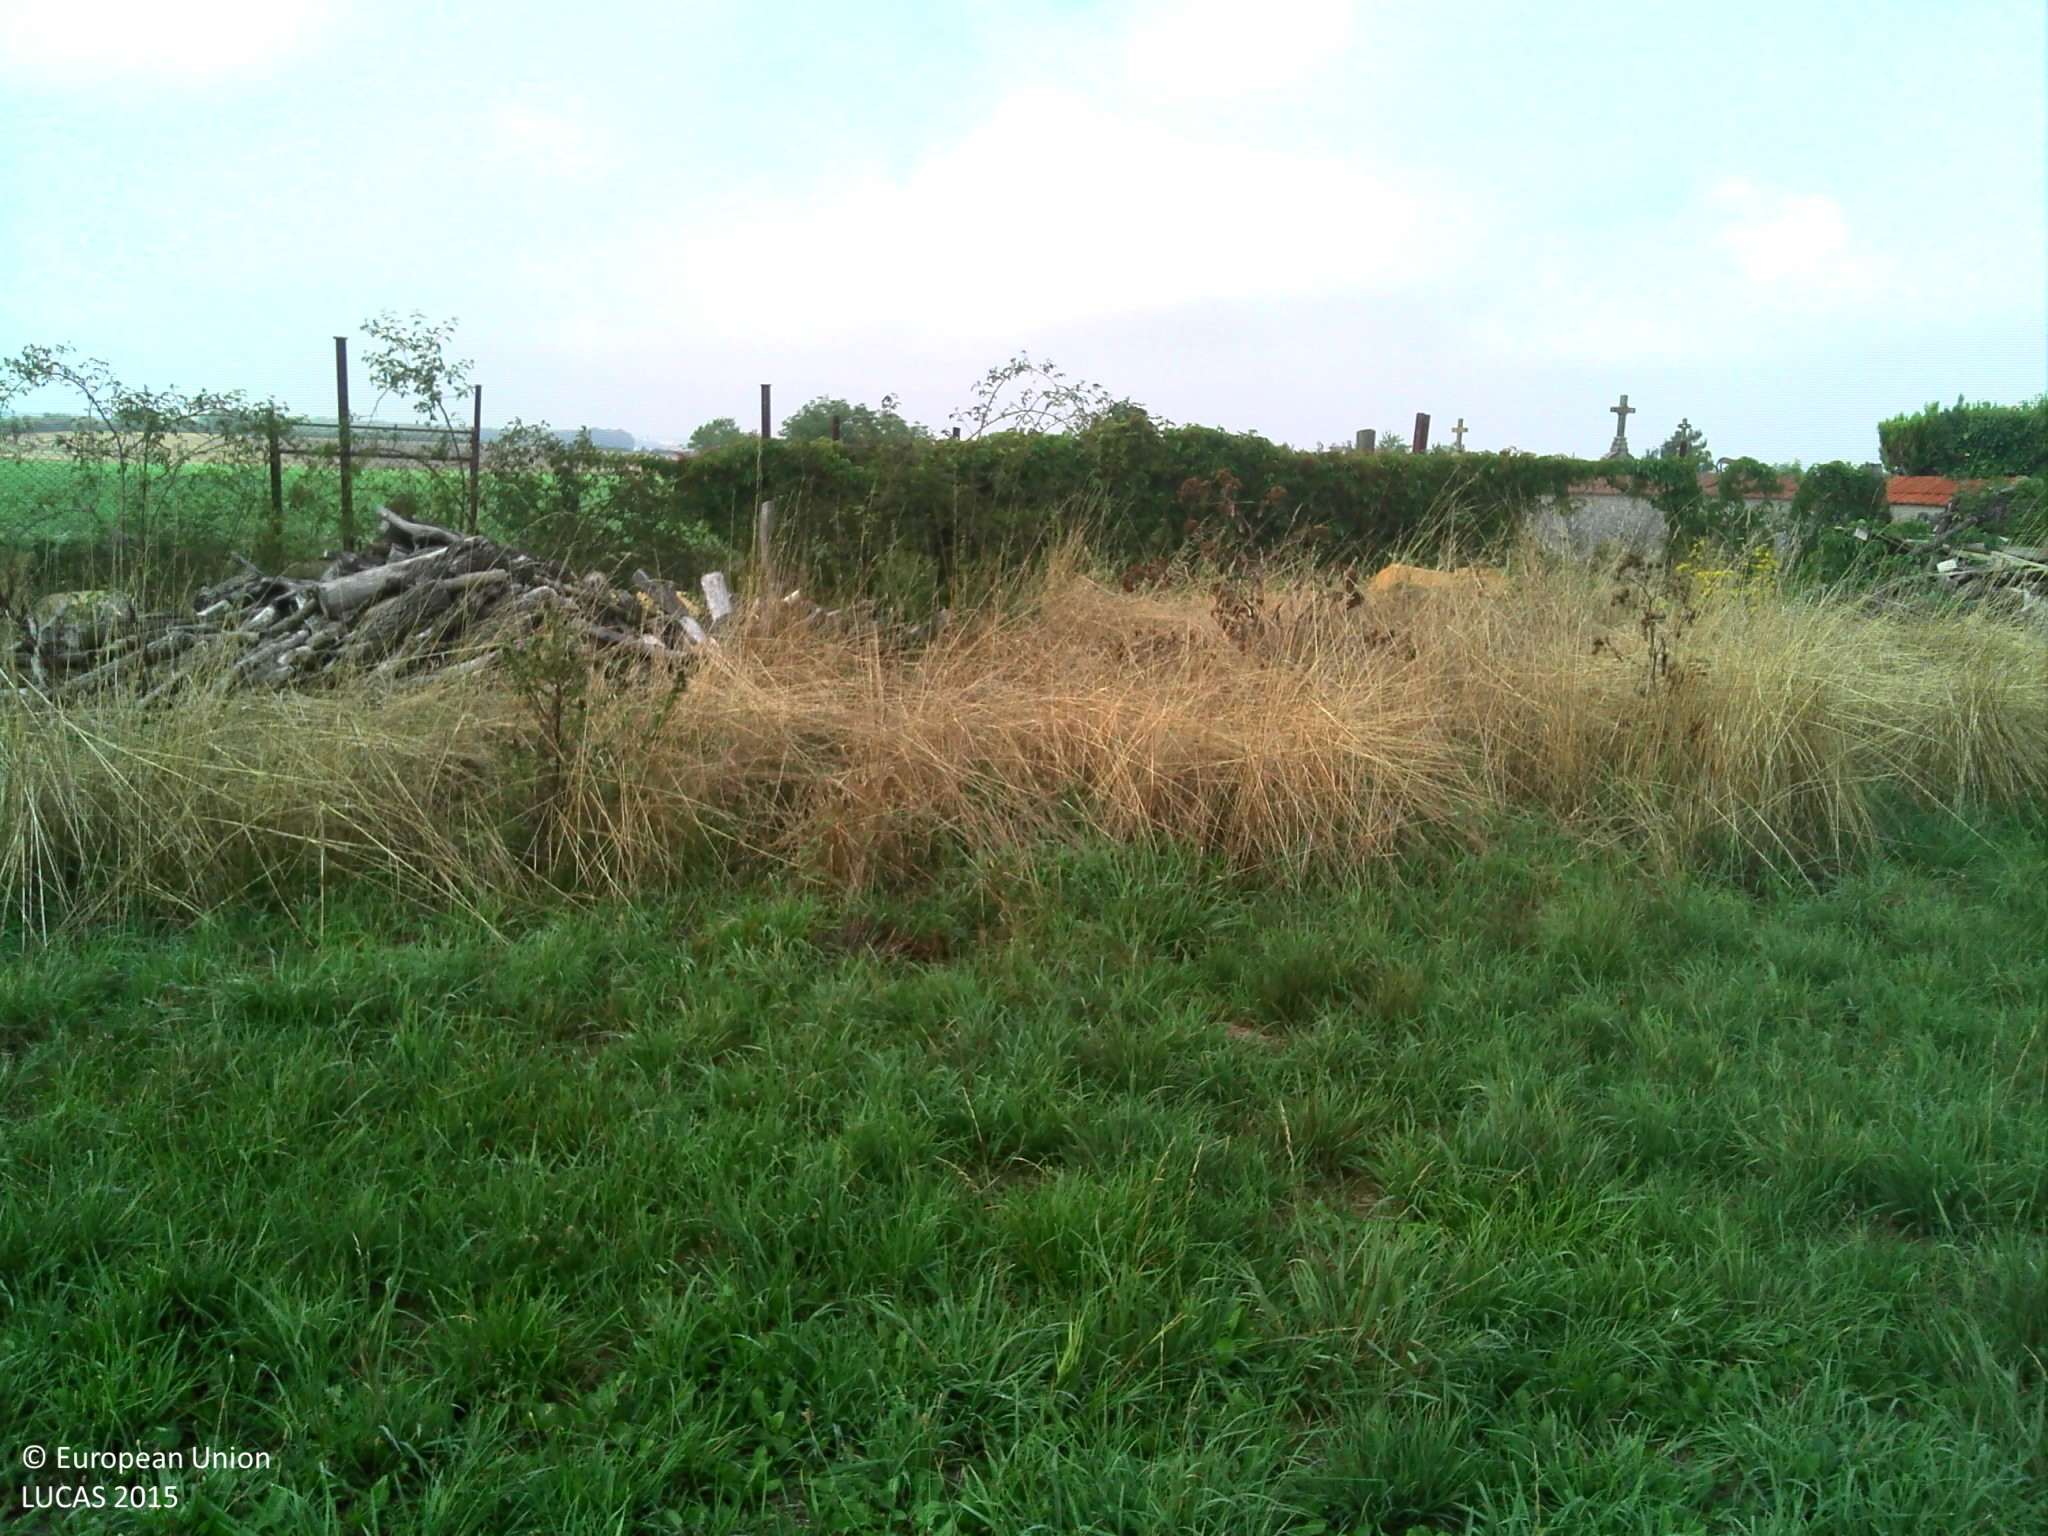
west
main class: Grassland
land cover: Grassland without tree/shrub cover
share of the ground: > 75 %
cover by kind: herbaceous plants 95 %, consolidated bare surface 5 %
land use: Agriculture (excluding fallow land and kitchen gardens)
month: September
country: FR
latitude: 49.1581
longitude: 5.9543
